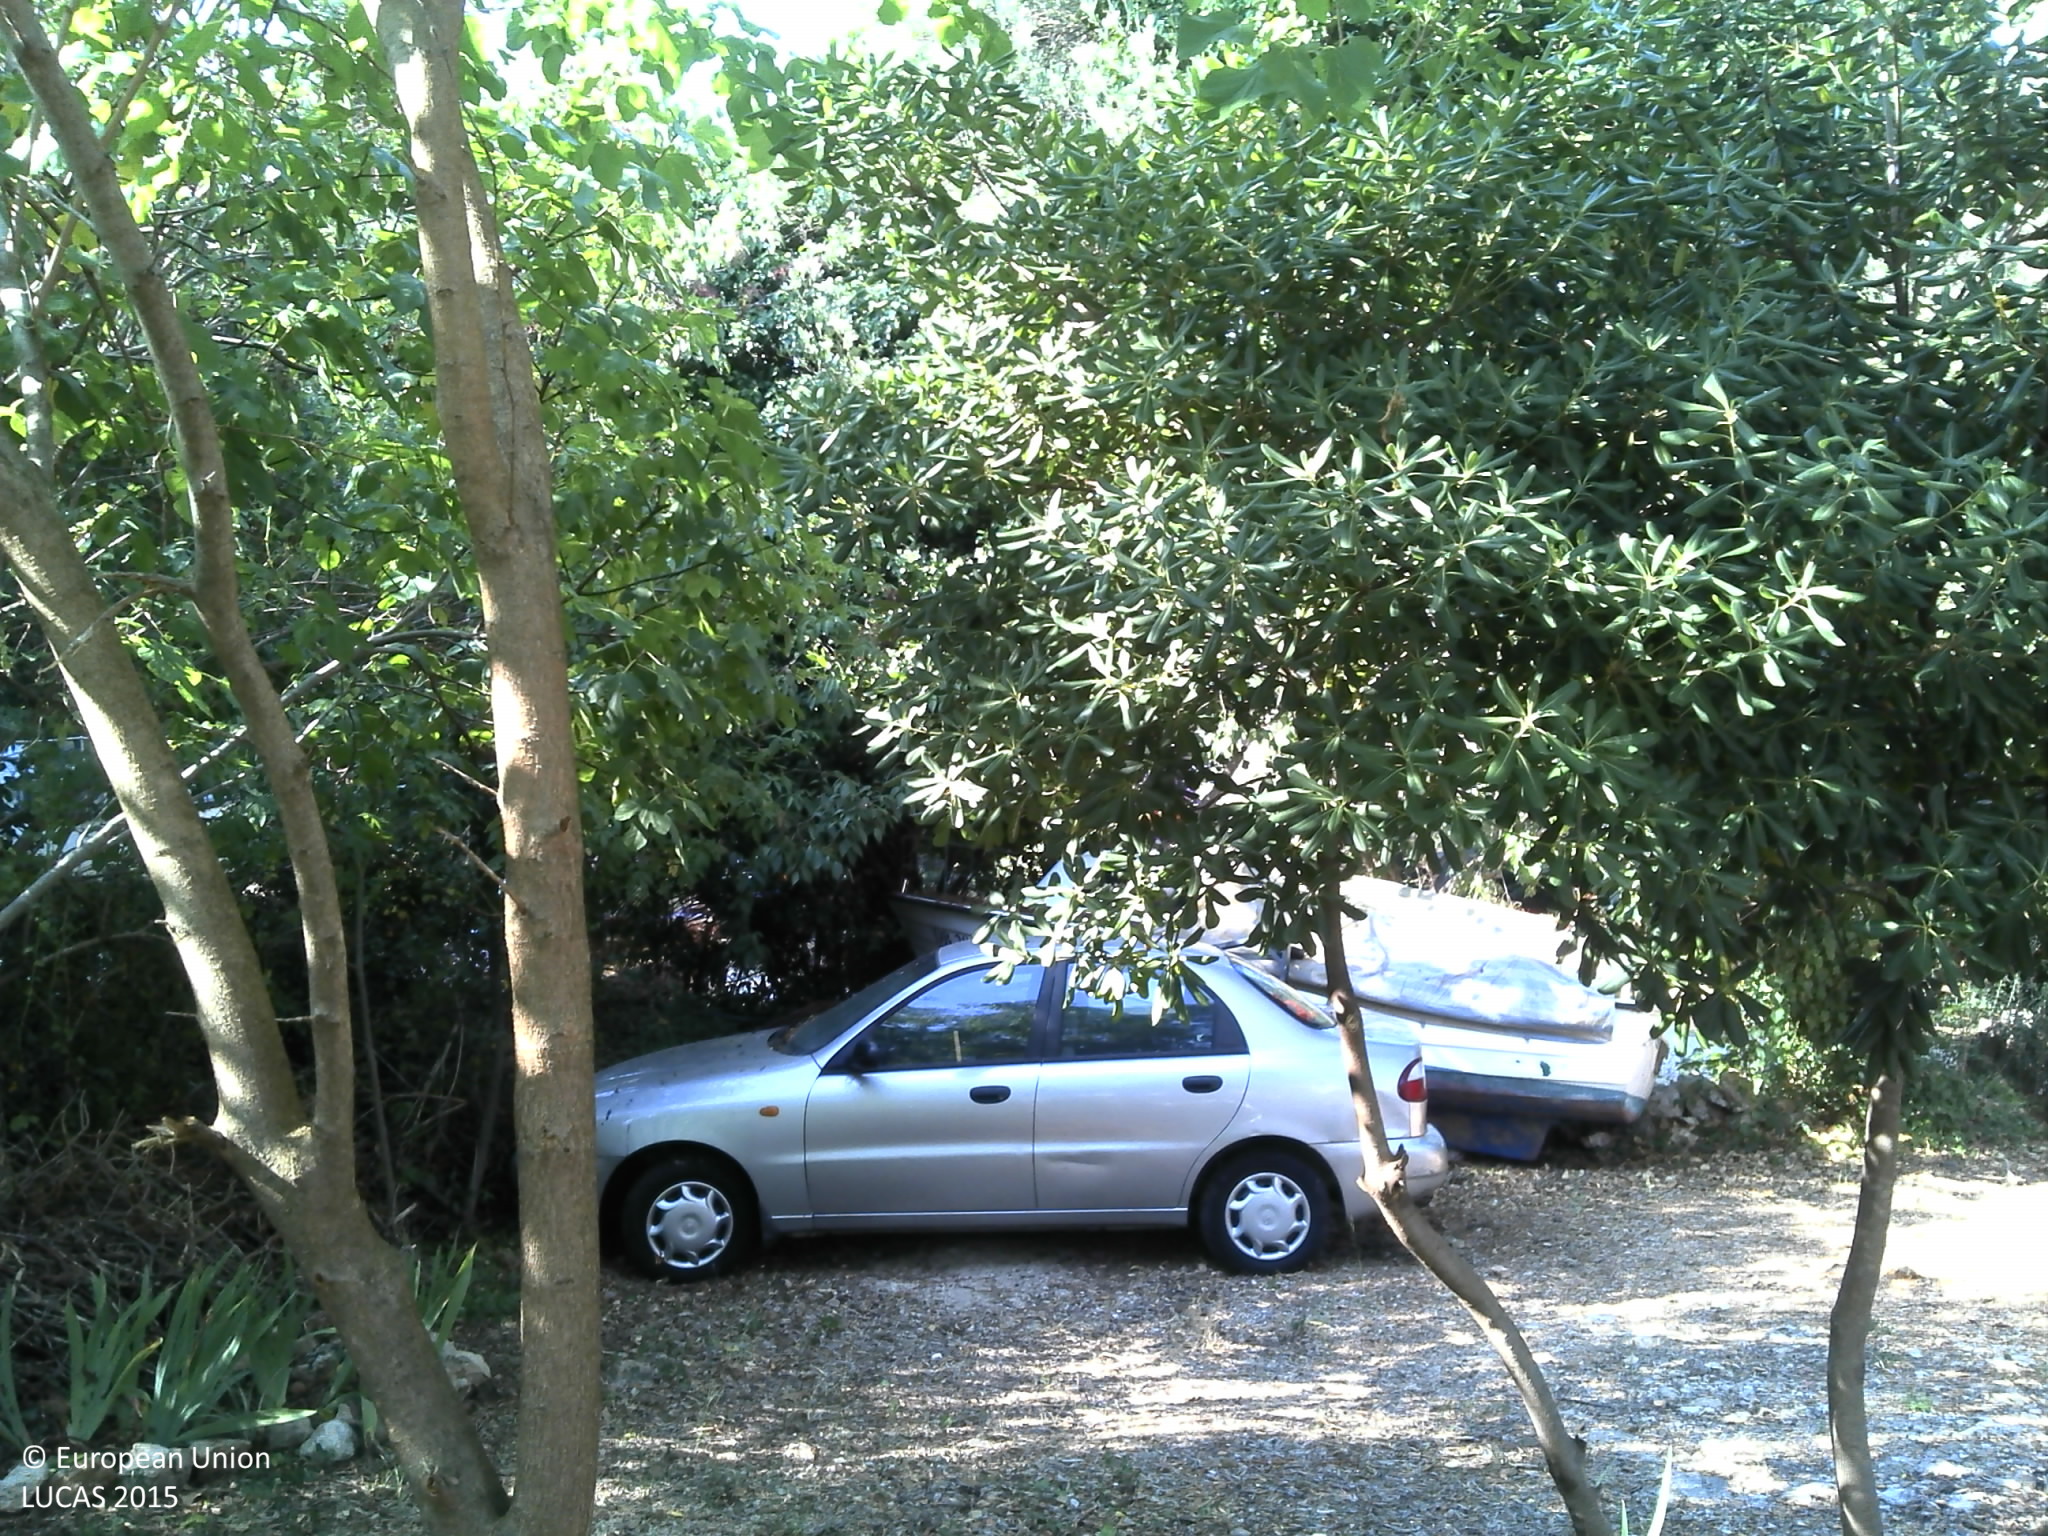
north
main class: Woodland
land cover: Broadleaved woodland
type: thermophilous deciduous forest
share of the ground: 50 - 75 %
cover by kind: broadleaved forest trees 55 %, herbaceous plants 15 %, coniferous forest trees 10 %, consolidated bare surface 10 %, lichens and mosses 5 %, unconsolidated bare surface 5 %
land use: Amenities, museums, leisure
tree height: > 5 m
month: July
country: HR
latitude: 42.6575
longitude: 18.0783
